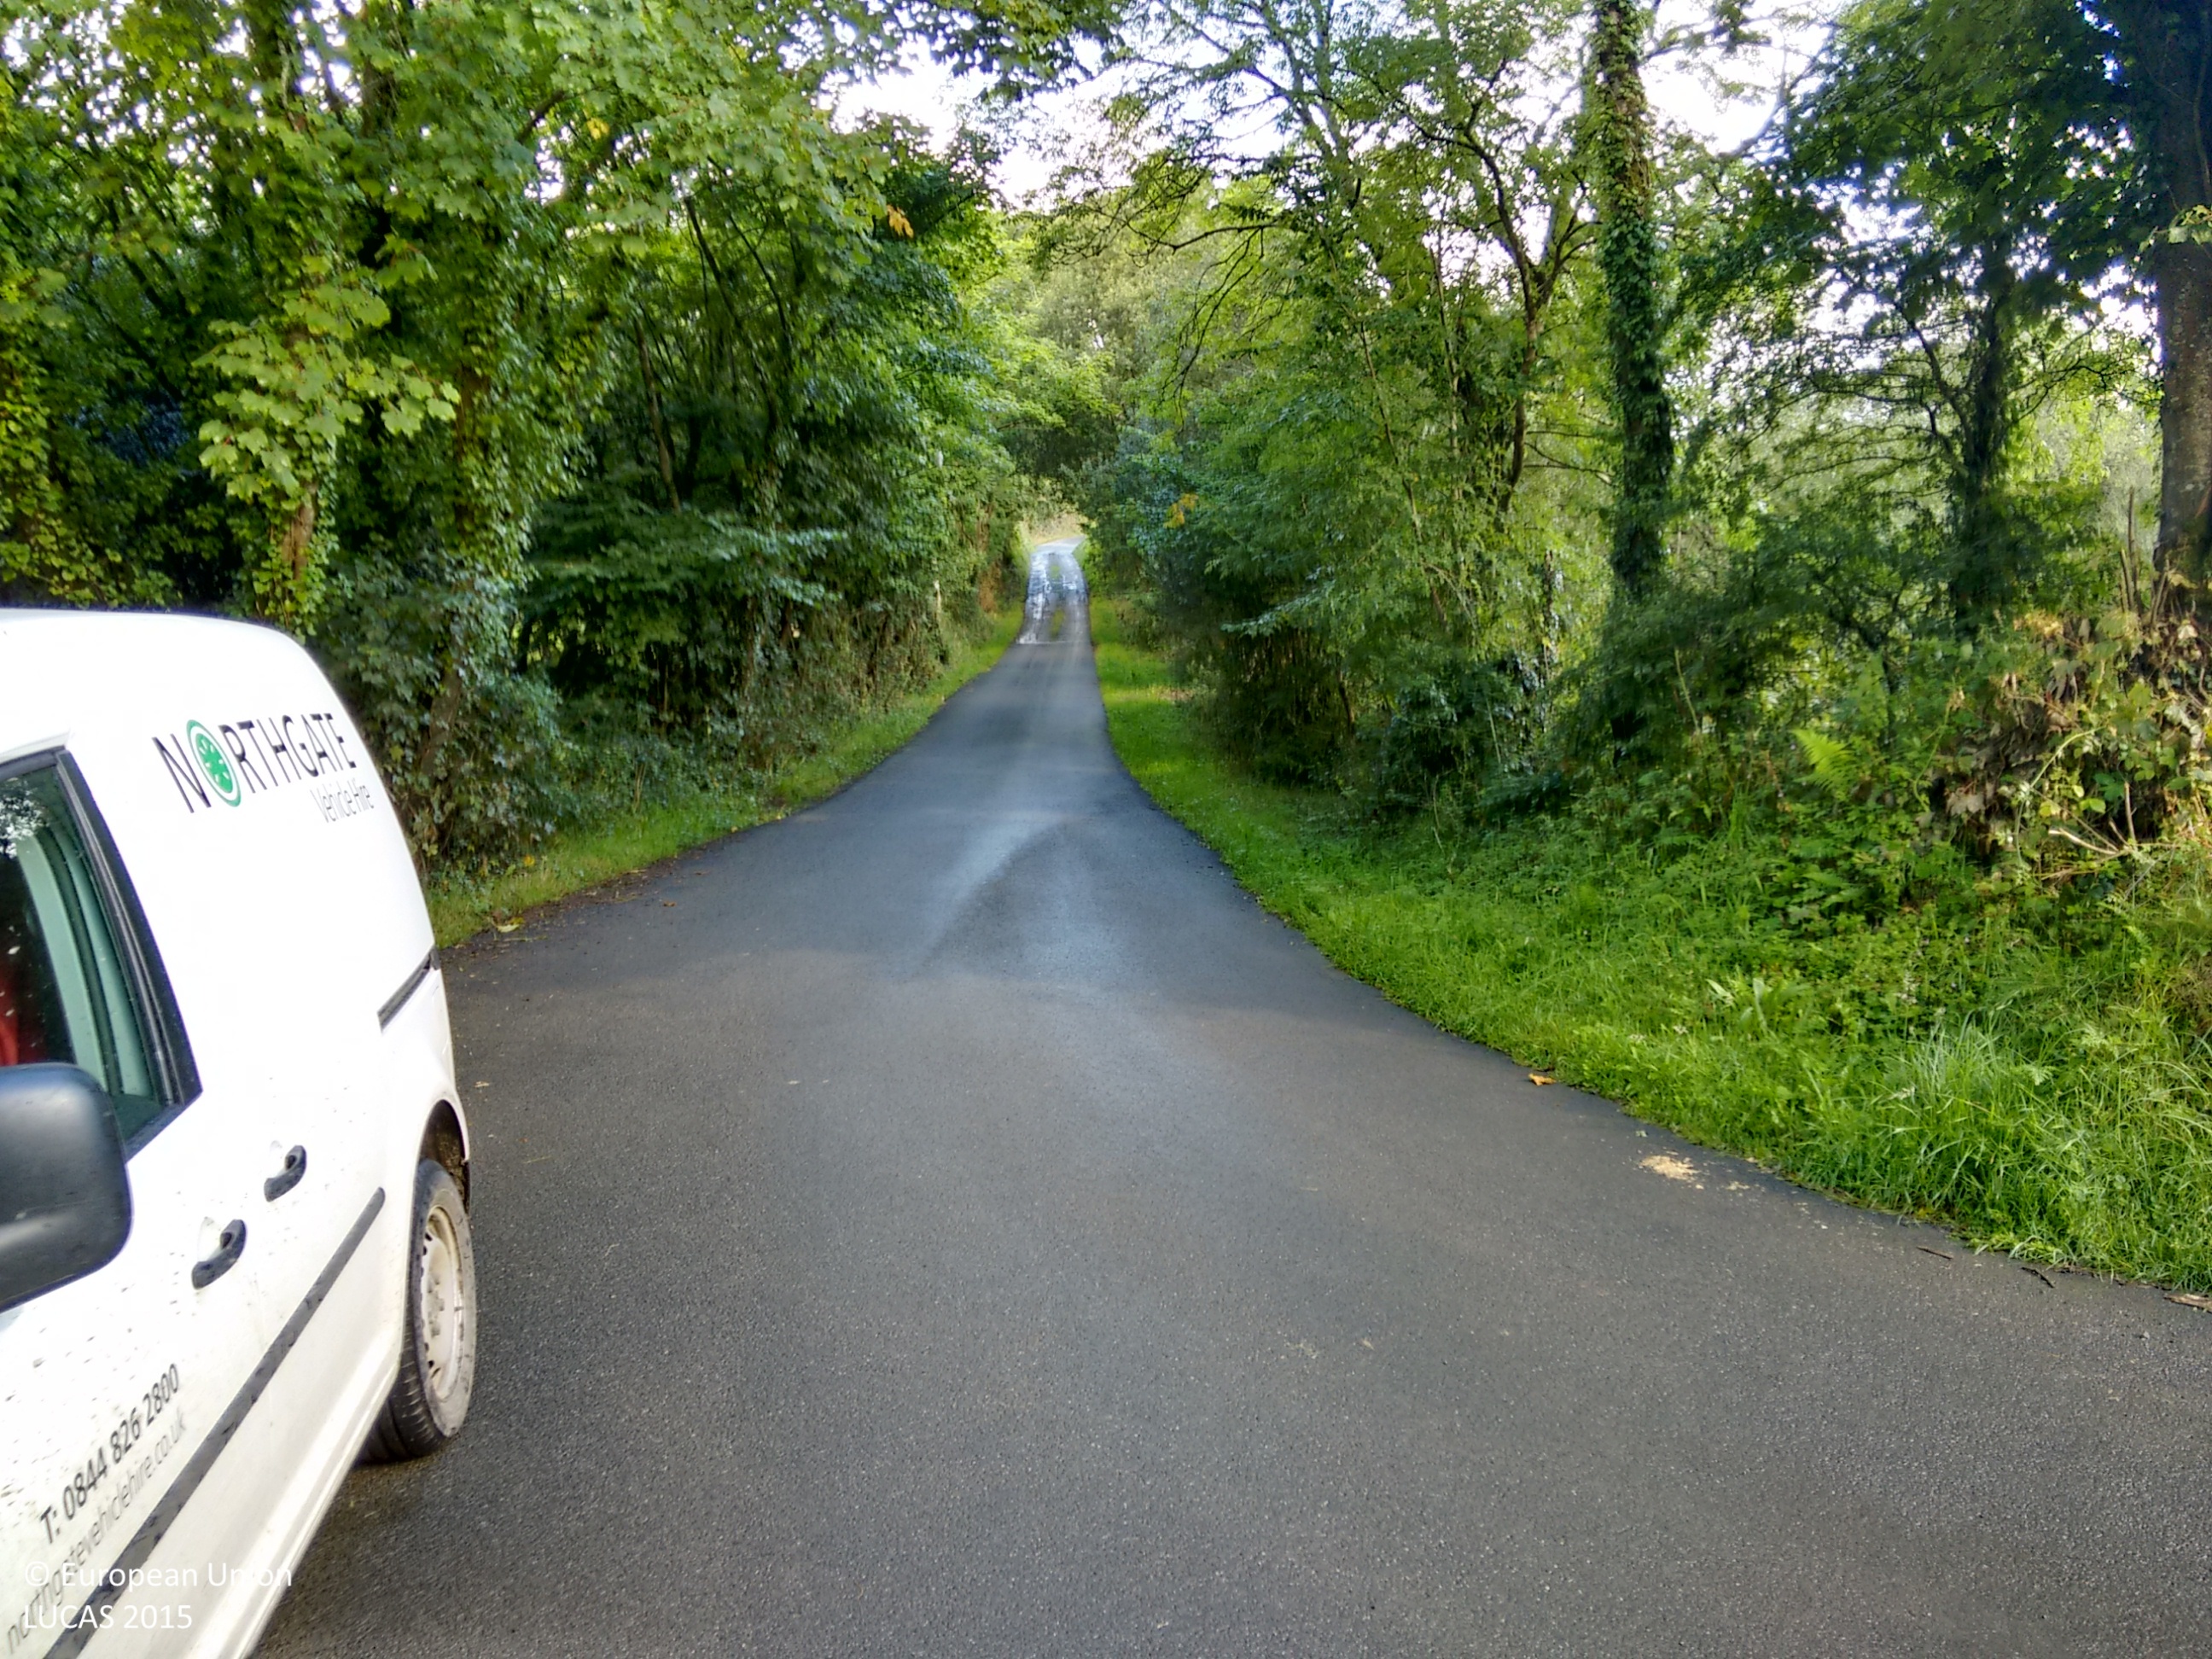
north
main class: Woodland
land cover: Broadleaved woodland
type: mesophytic deciduous forest
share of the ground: > 75 %
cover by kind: broadleaved forest trees 80 %, shrubs 20 %
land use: Semi-natural and natural areas not in use
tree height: > 5 m
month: August
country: GB
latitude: 51.9936
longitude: -4.9267
